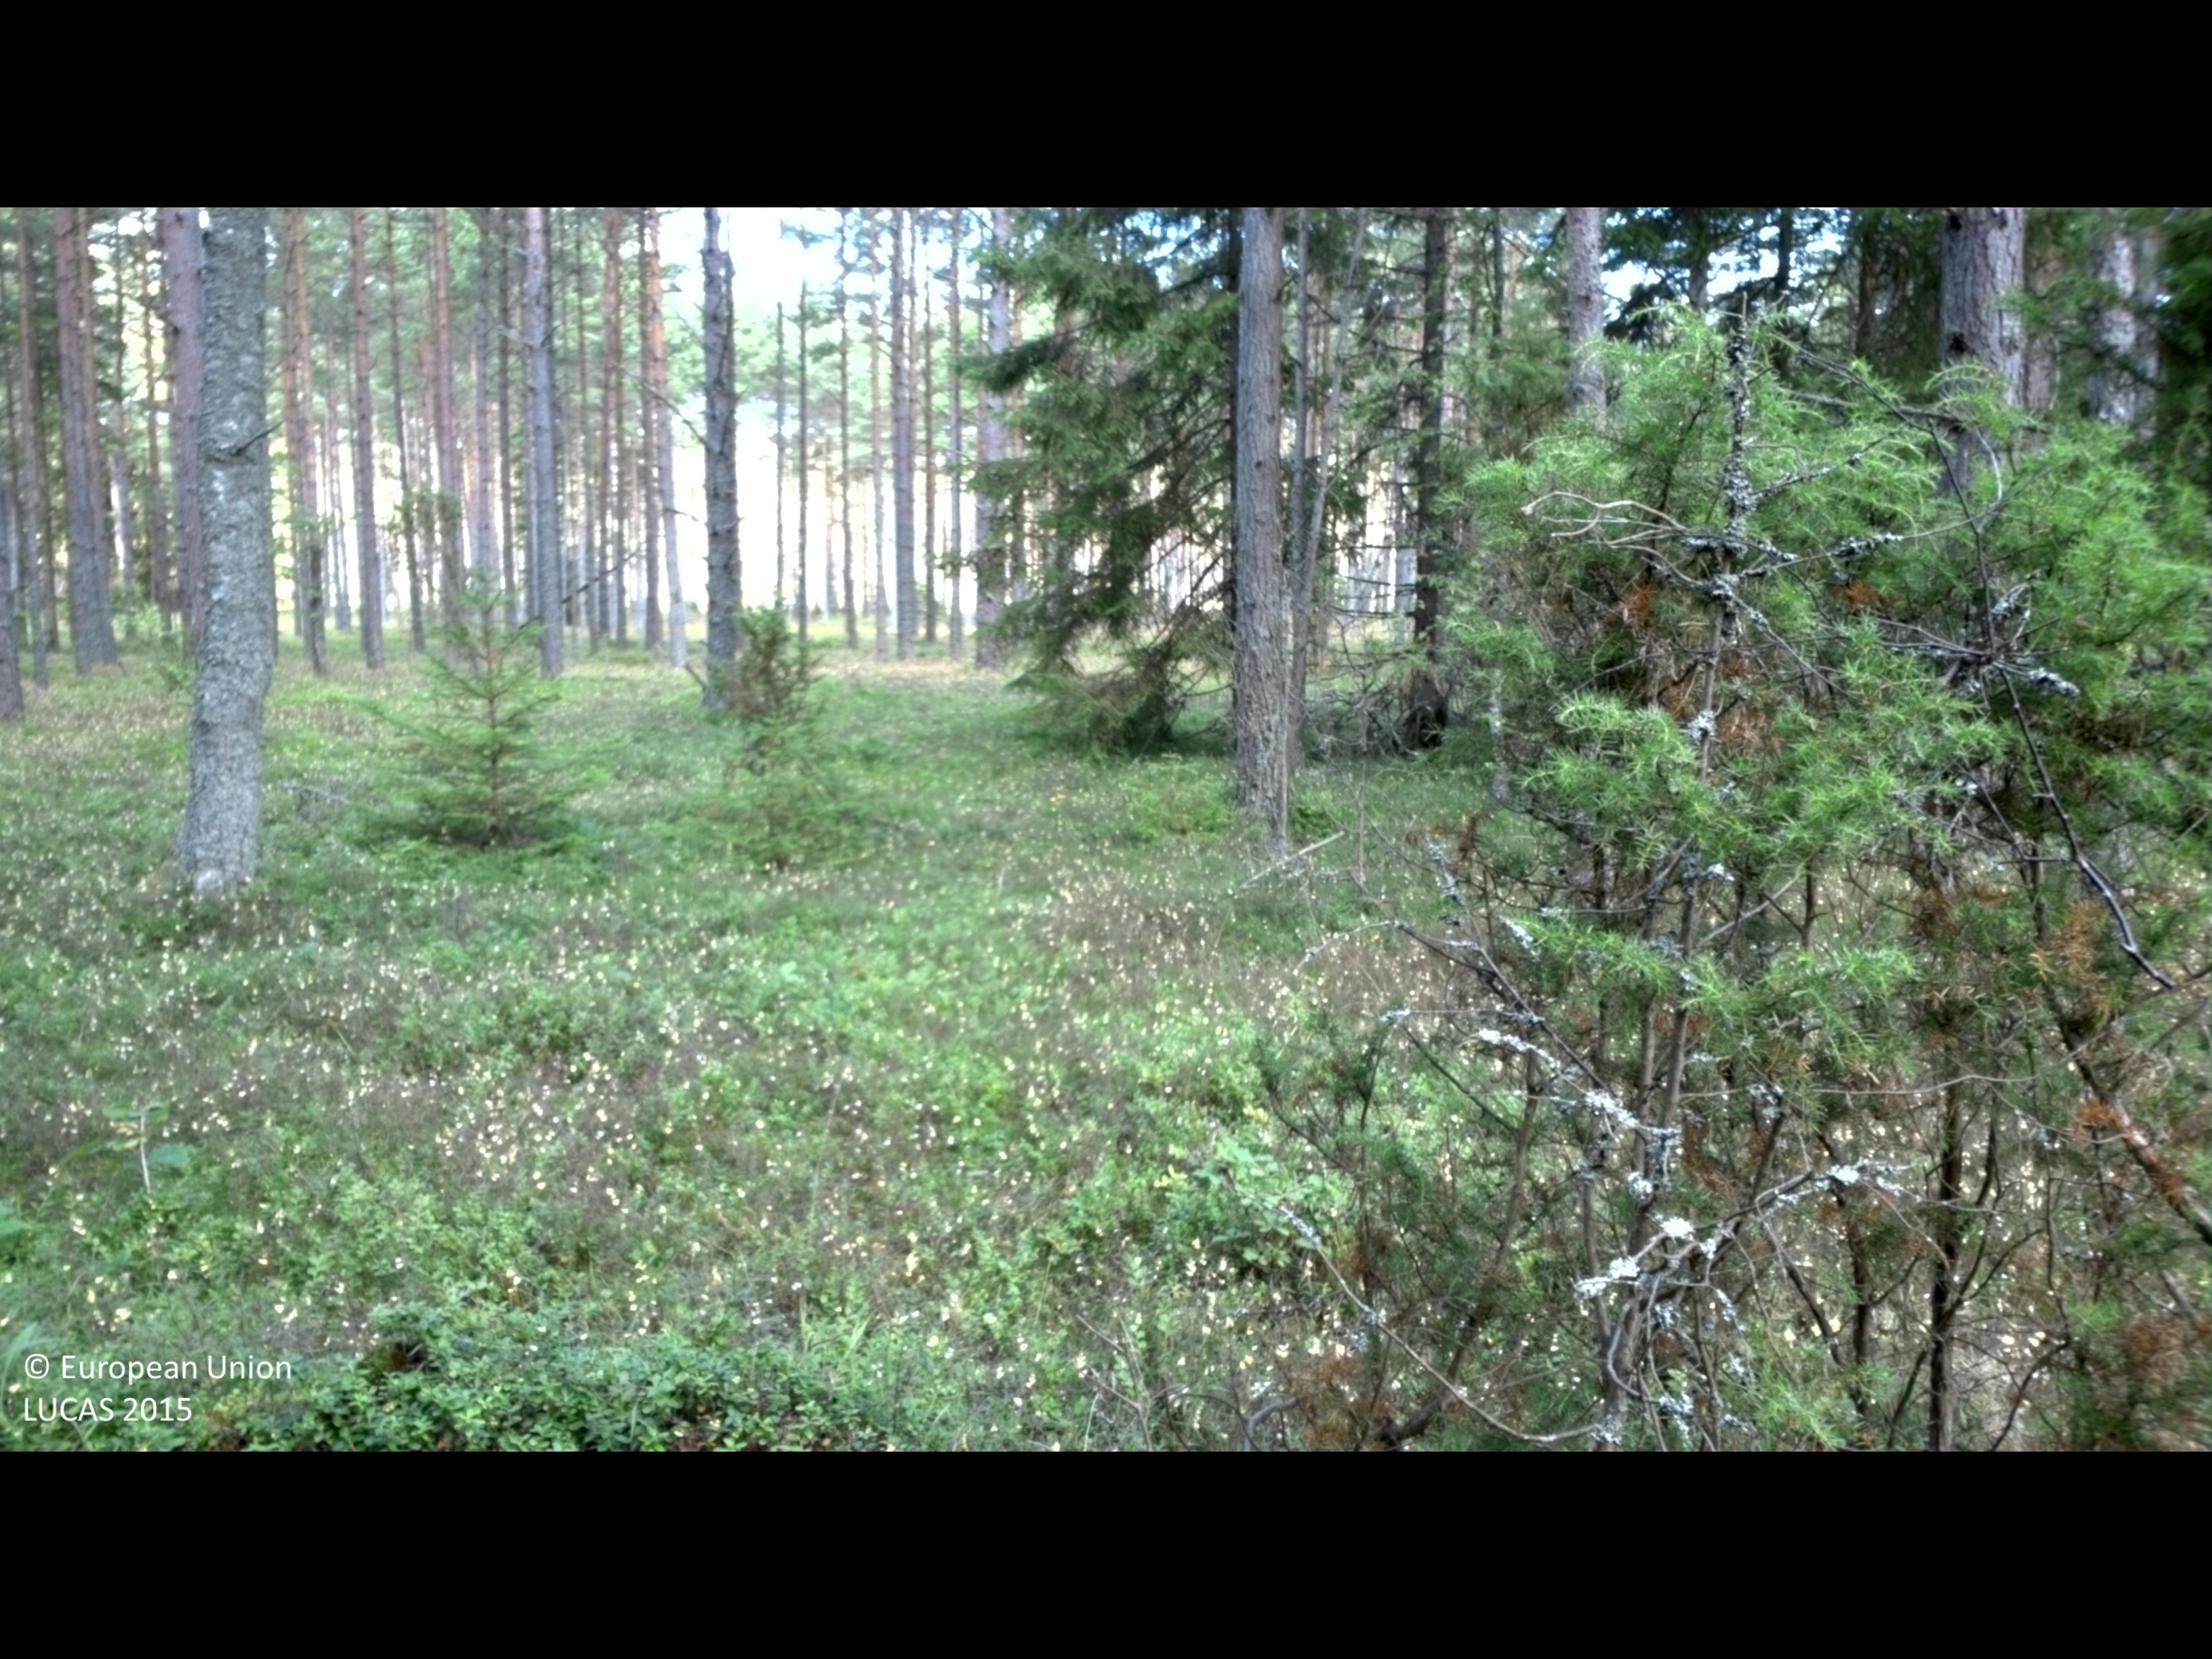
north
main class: Woodland
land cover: Pine dominated coniferous woodland
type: boreal forest
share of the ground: 50 - 75 %
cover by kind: coniferous forest trees 65 %, shrubs 20 %, herbaceous plants 10 %, lichens and mosses 5 %
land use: Forestry
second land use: Amenities, museums, leisure
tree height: > 5 m
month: July
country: SE
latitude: 57.3259
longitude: 17.1269
